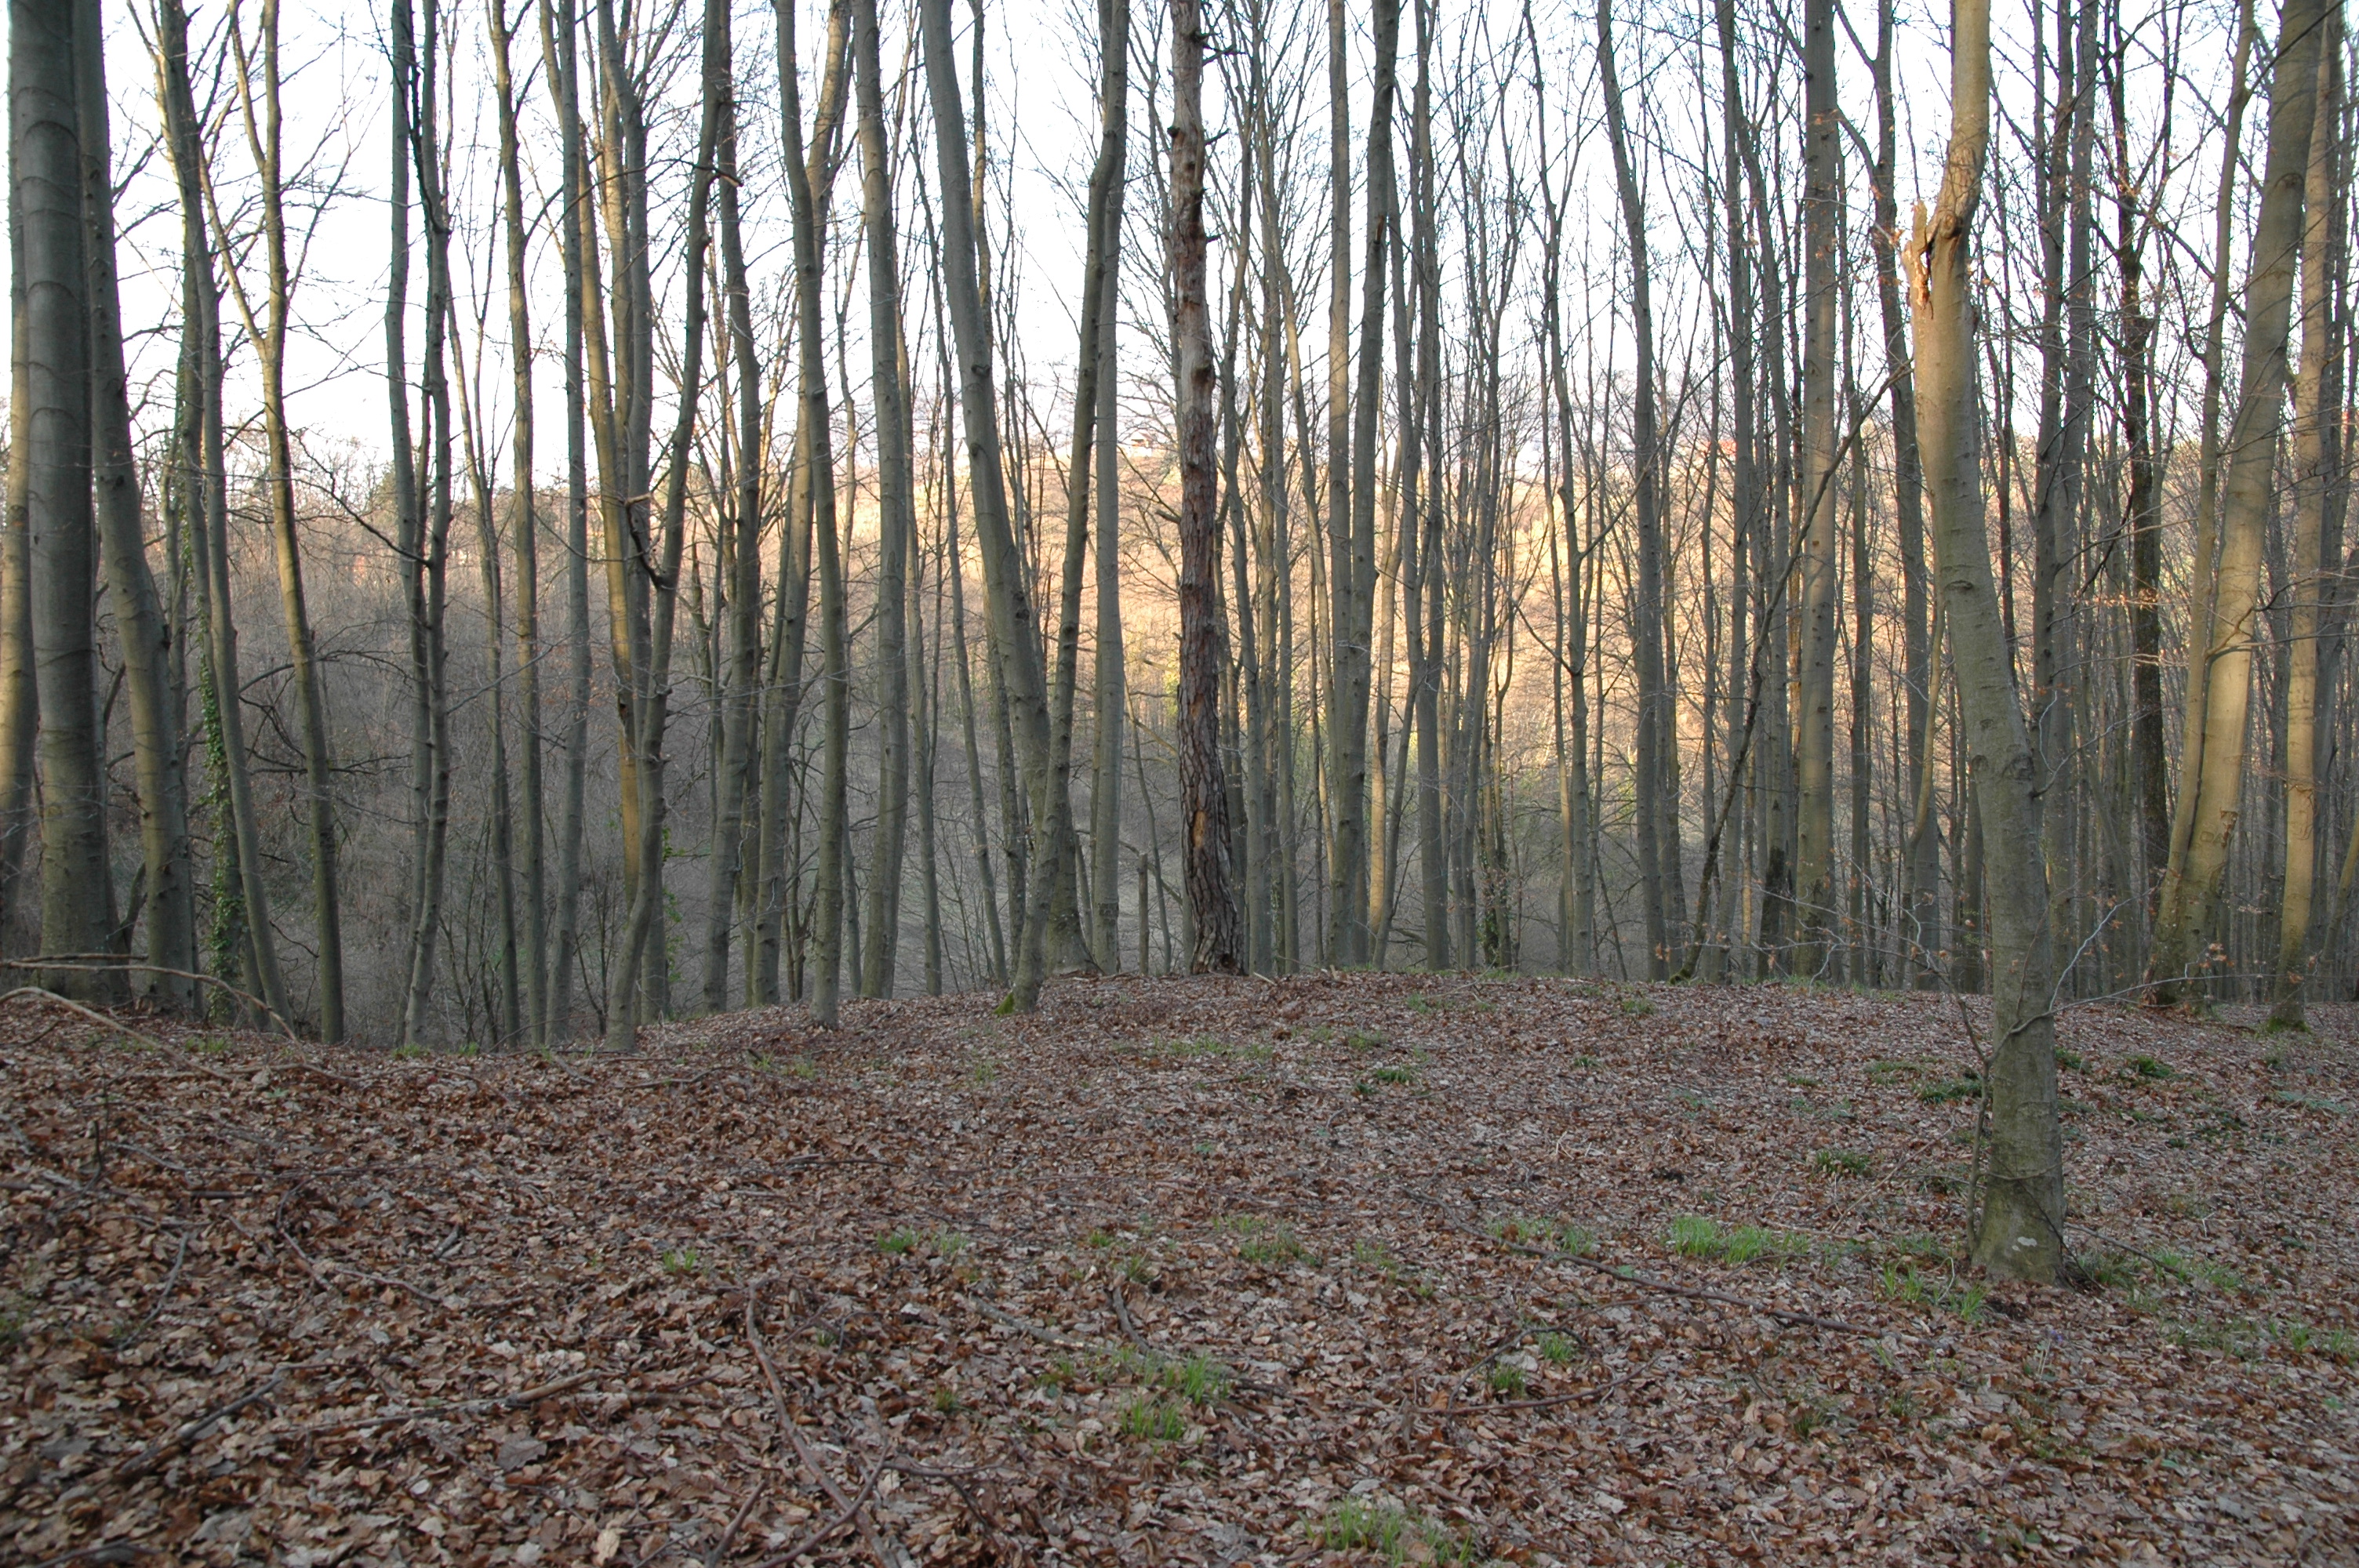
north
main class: Woodland
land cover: Broadleaved woodland
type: beech forest
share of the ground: > 75 %
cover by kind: broadleaved forest trees 90 %, shrubs 5 %, herbaceous plants 5 %
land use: Forestry
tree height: > 5 m
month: March
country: HR
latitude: 46.2397
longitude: 15.9515
